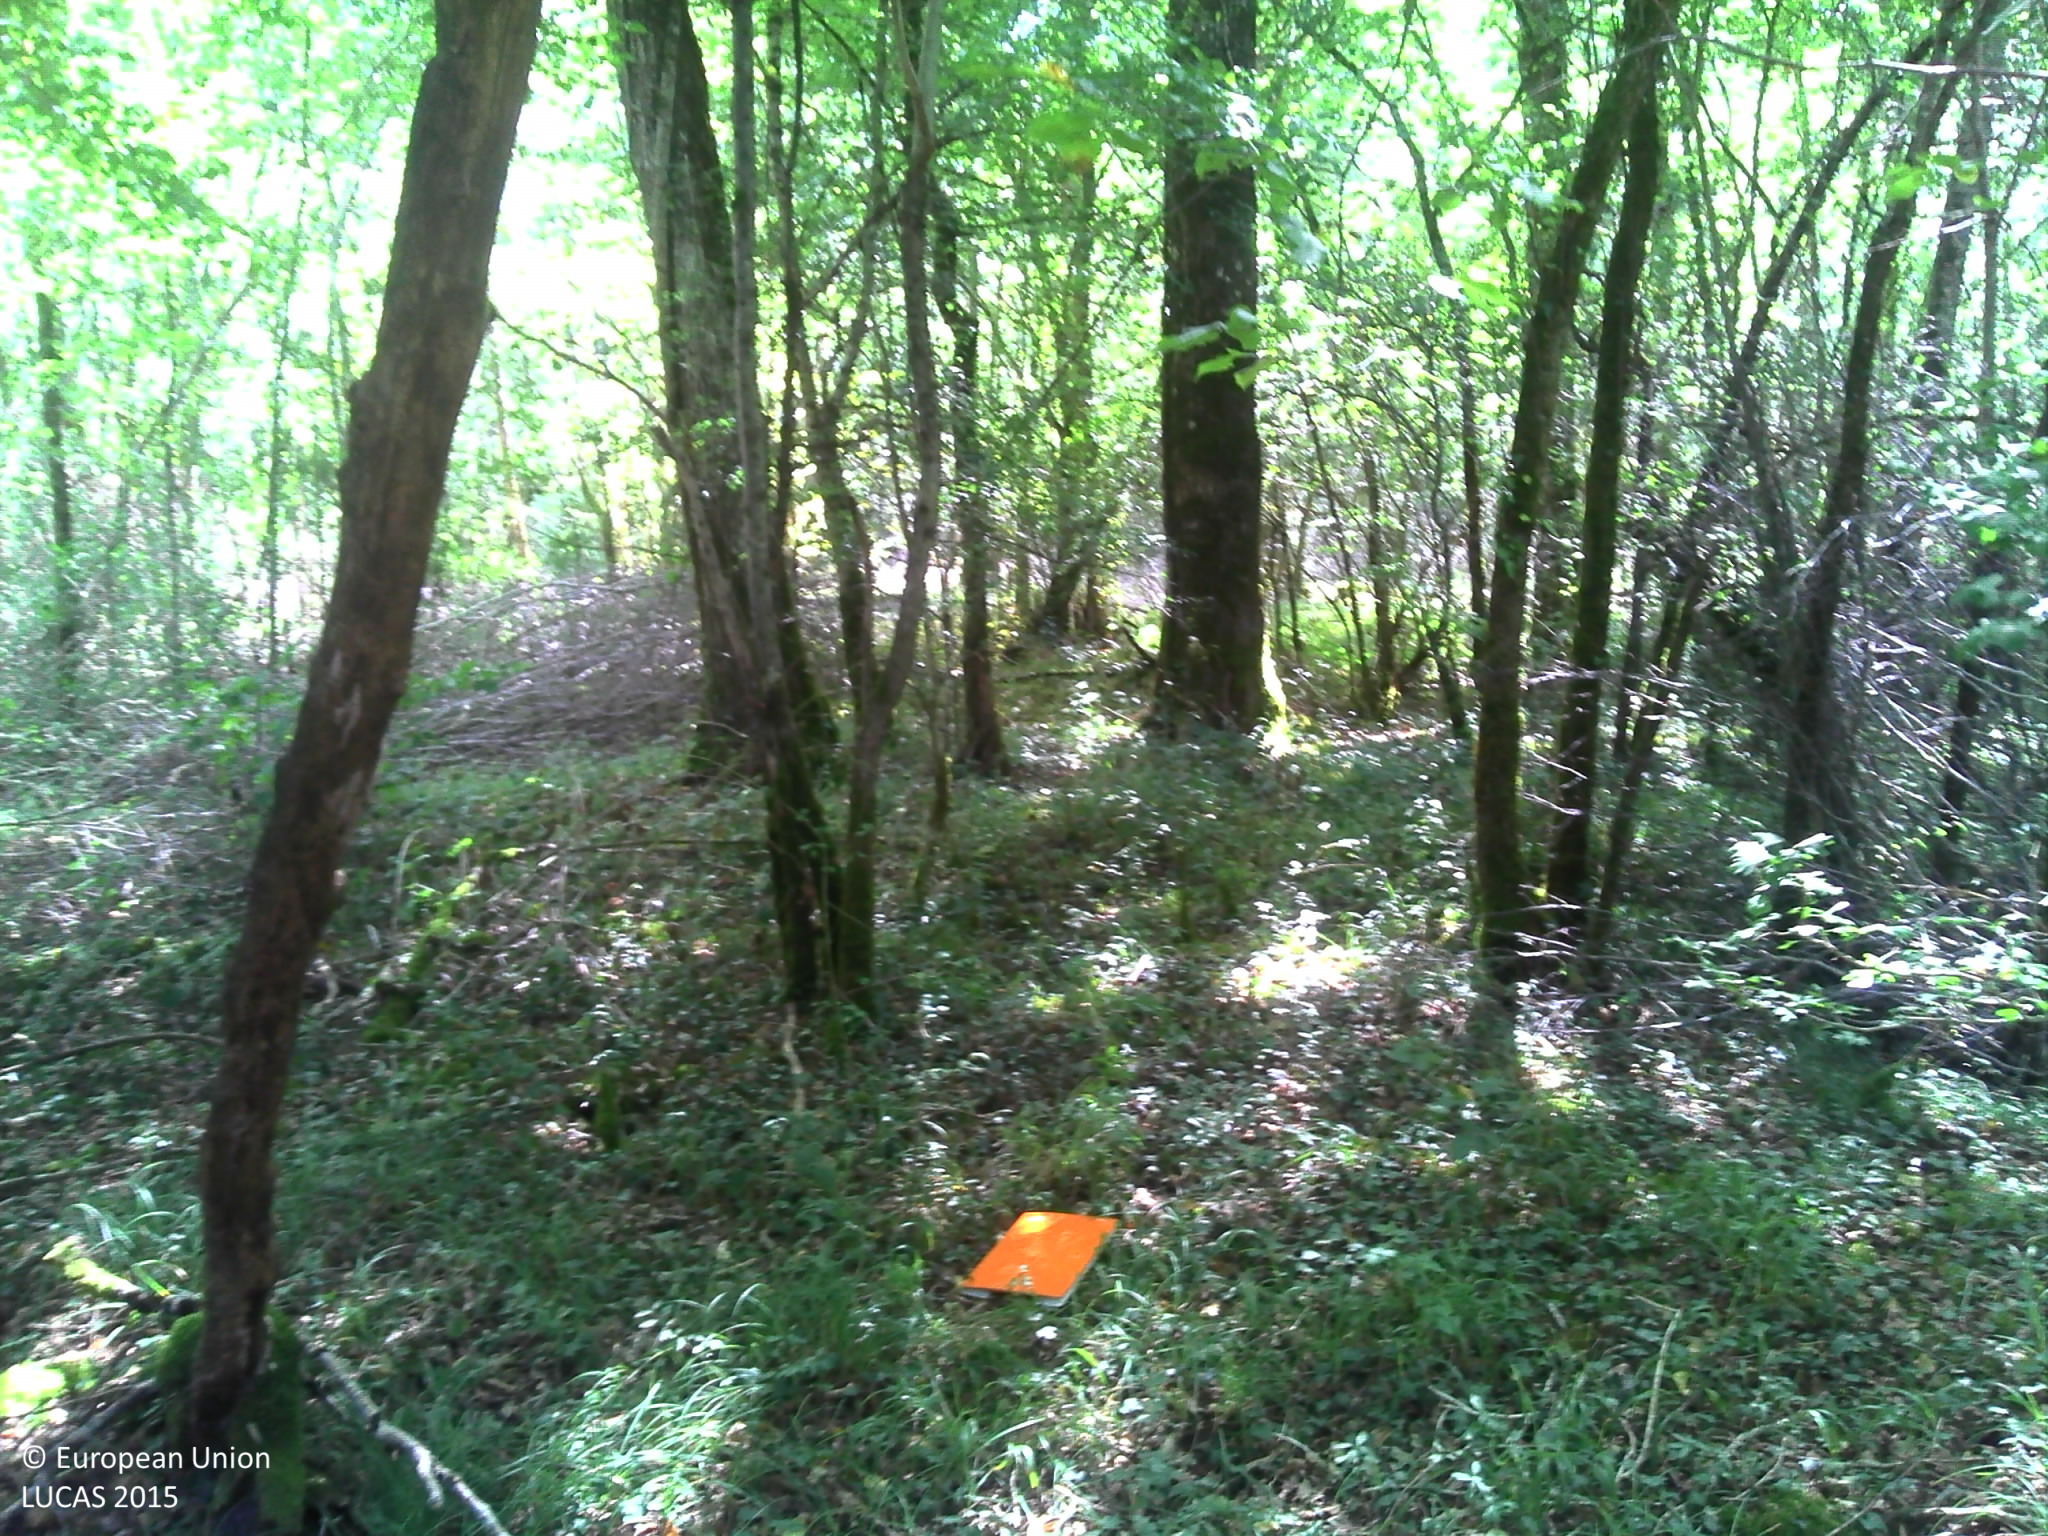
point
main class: Woodland
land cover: Broadleaved woodland
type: mesophytic deciduous forest
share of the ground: > 75 %
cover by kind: broadleaved forest trees 90 %, herbaceous plants 10 %
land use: Forestry
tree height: > 5 m
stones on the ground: < 10 %
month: September
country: FR
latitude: 46.7898
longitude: 1.4867
